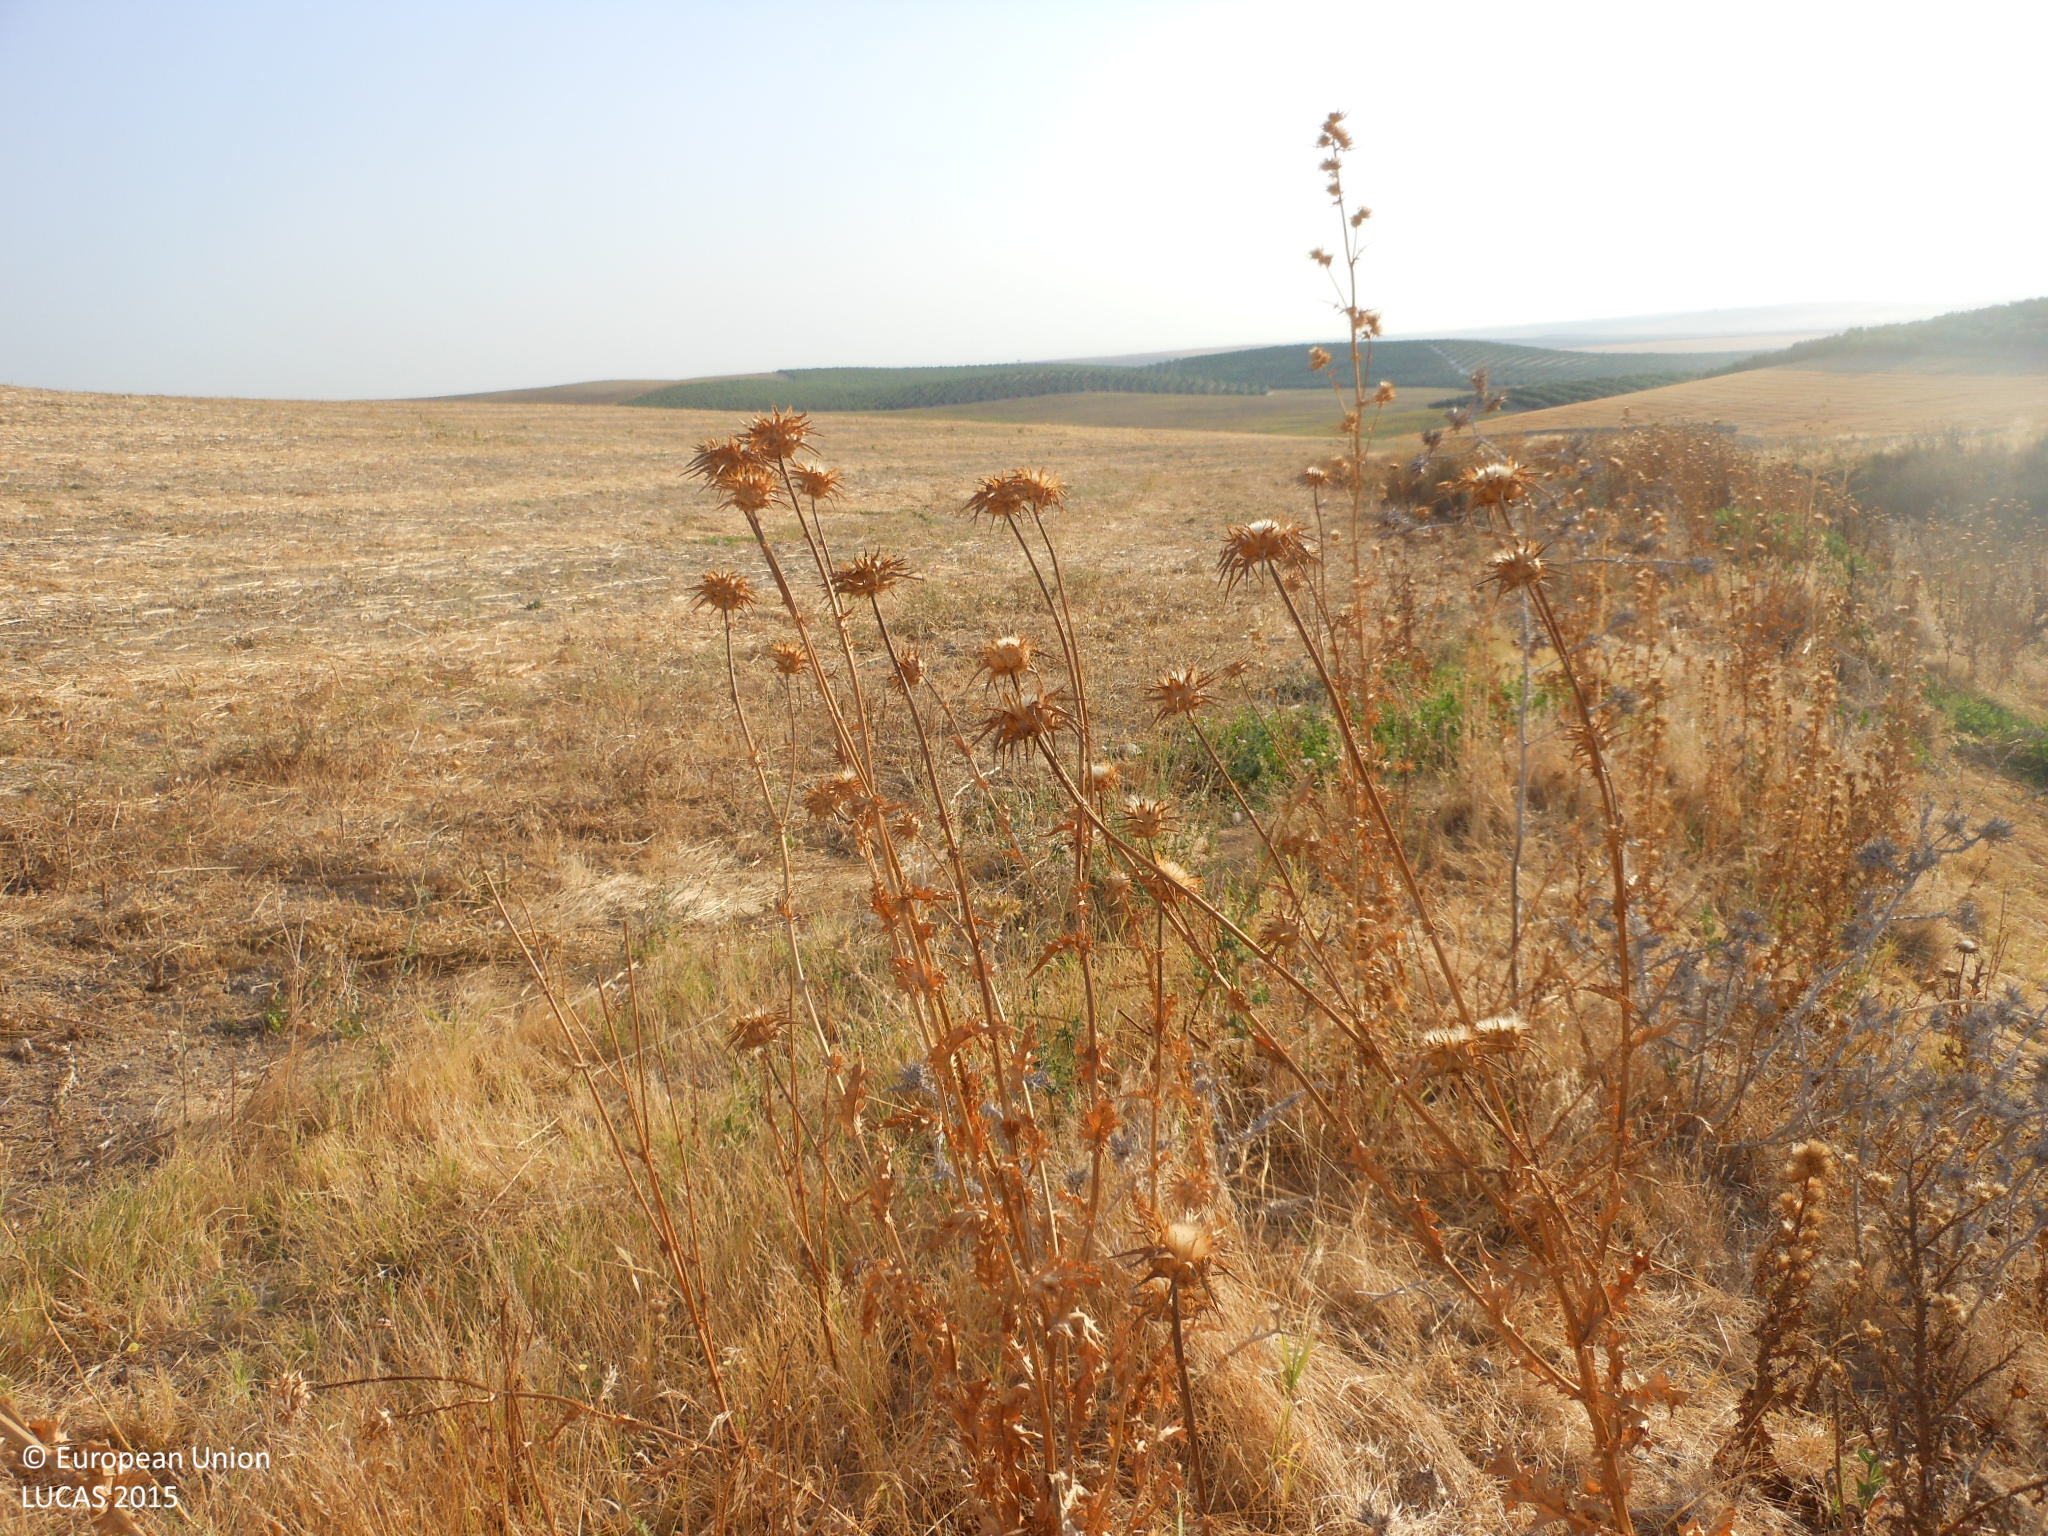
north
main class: Grassland
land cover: Grassland without tree/shrub cover
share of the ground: > 75 %
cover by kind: herbaceous plants 85 %, consolidated bare surface 15 %
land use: Semi-natural and natural areas not in use
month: July
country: ES
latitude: 37.4683
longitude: -5.1291
